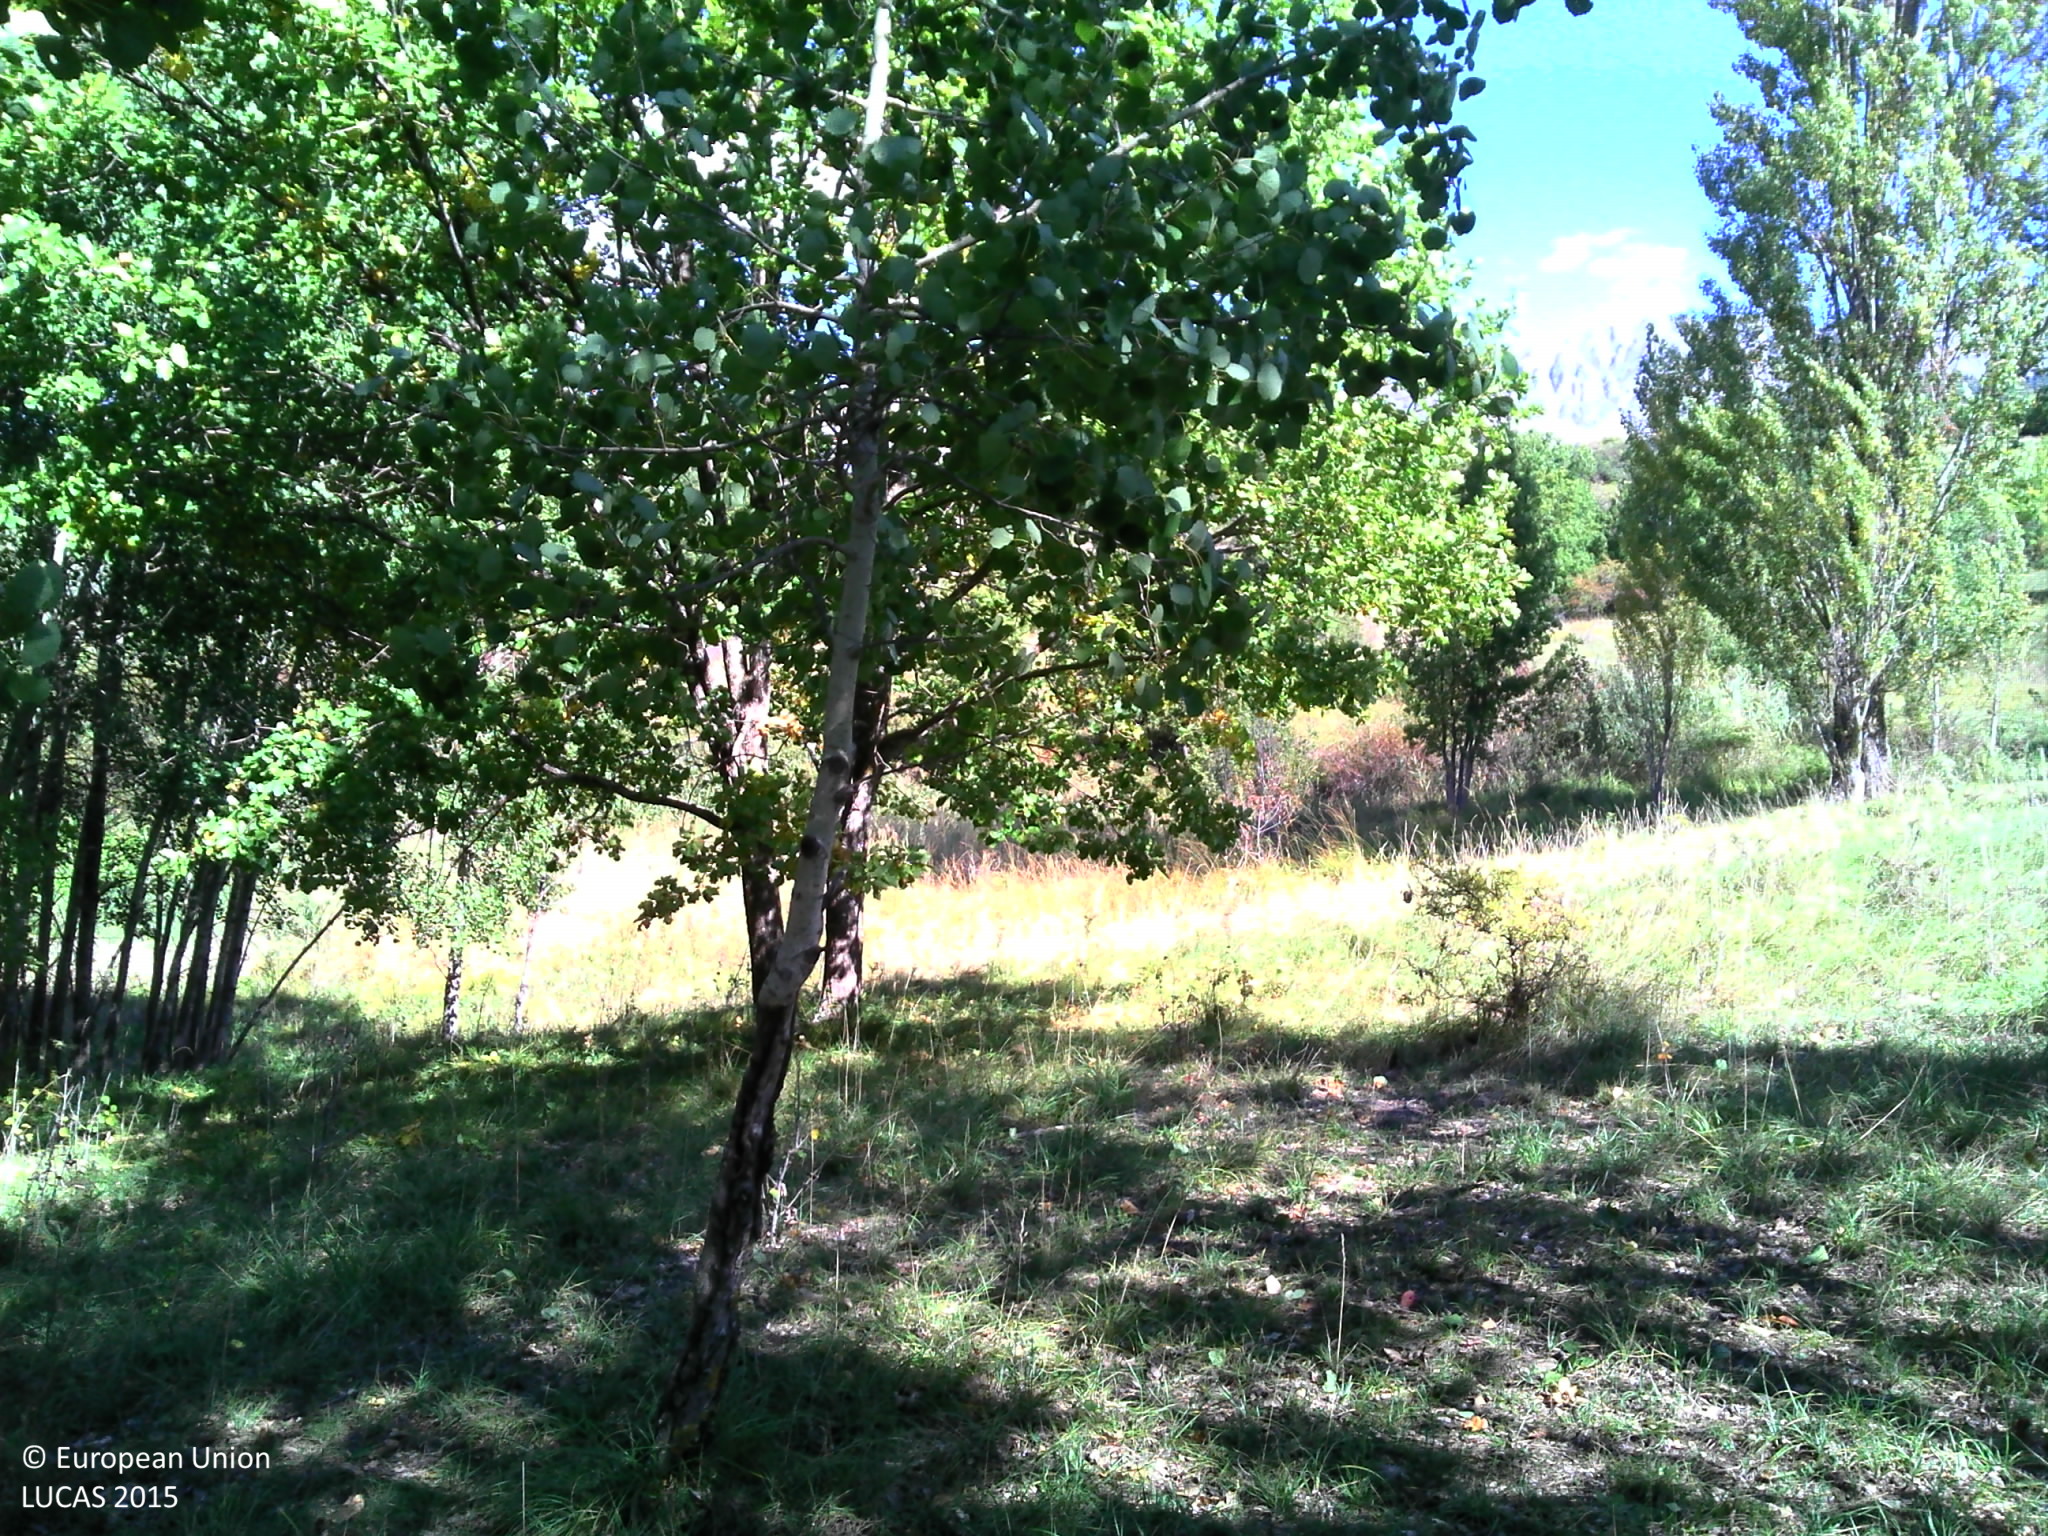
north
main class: Woodland
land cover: Broadleaved woodland
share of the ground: 25 - 50 %
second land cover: Grassland without tree/shrub cover
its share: > 75 %
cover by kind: broadleaved forest trees 70 %, herbaceous plants 25 %, coniferous forest trees 5 %
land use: Forestry
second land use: Agriculture (excluding fallow land and kitchen gardens)
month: October
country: FR
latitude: 44.5542
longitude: 6.2677
